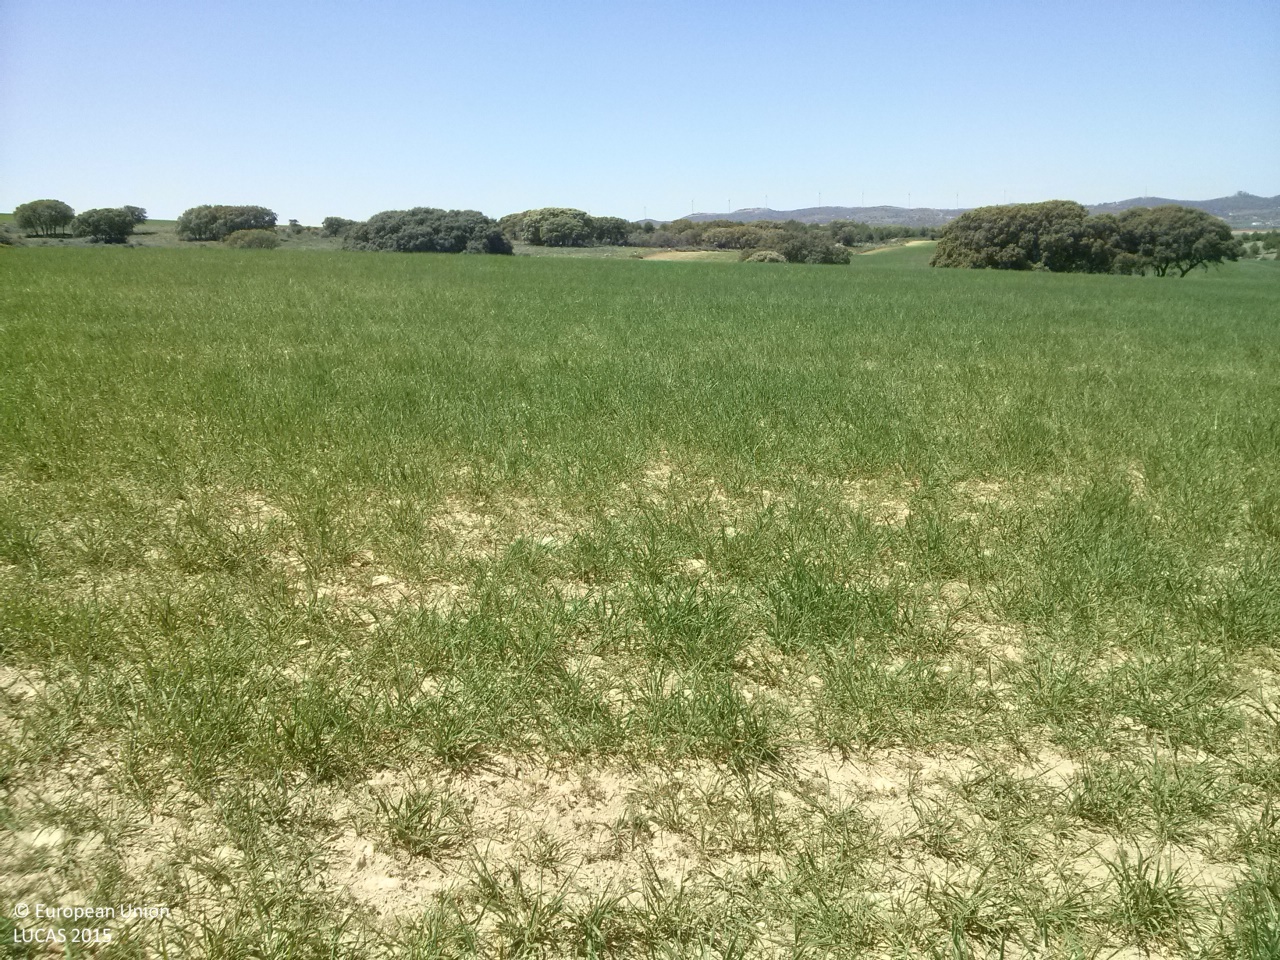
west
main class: Cropland
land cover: Barley
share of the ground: > 75 %
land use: Agriculture (excluding fallow land and kitchen gardens)
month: May
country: ES
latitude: 39.7785
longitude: -2.7563
